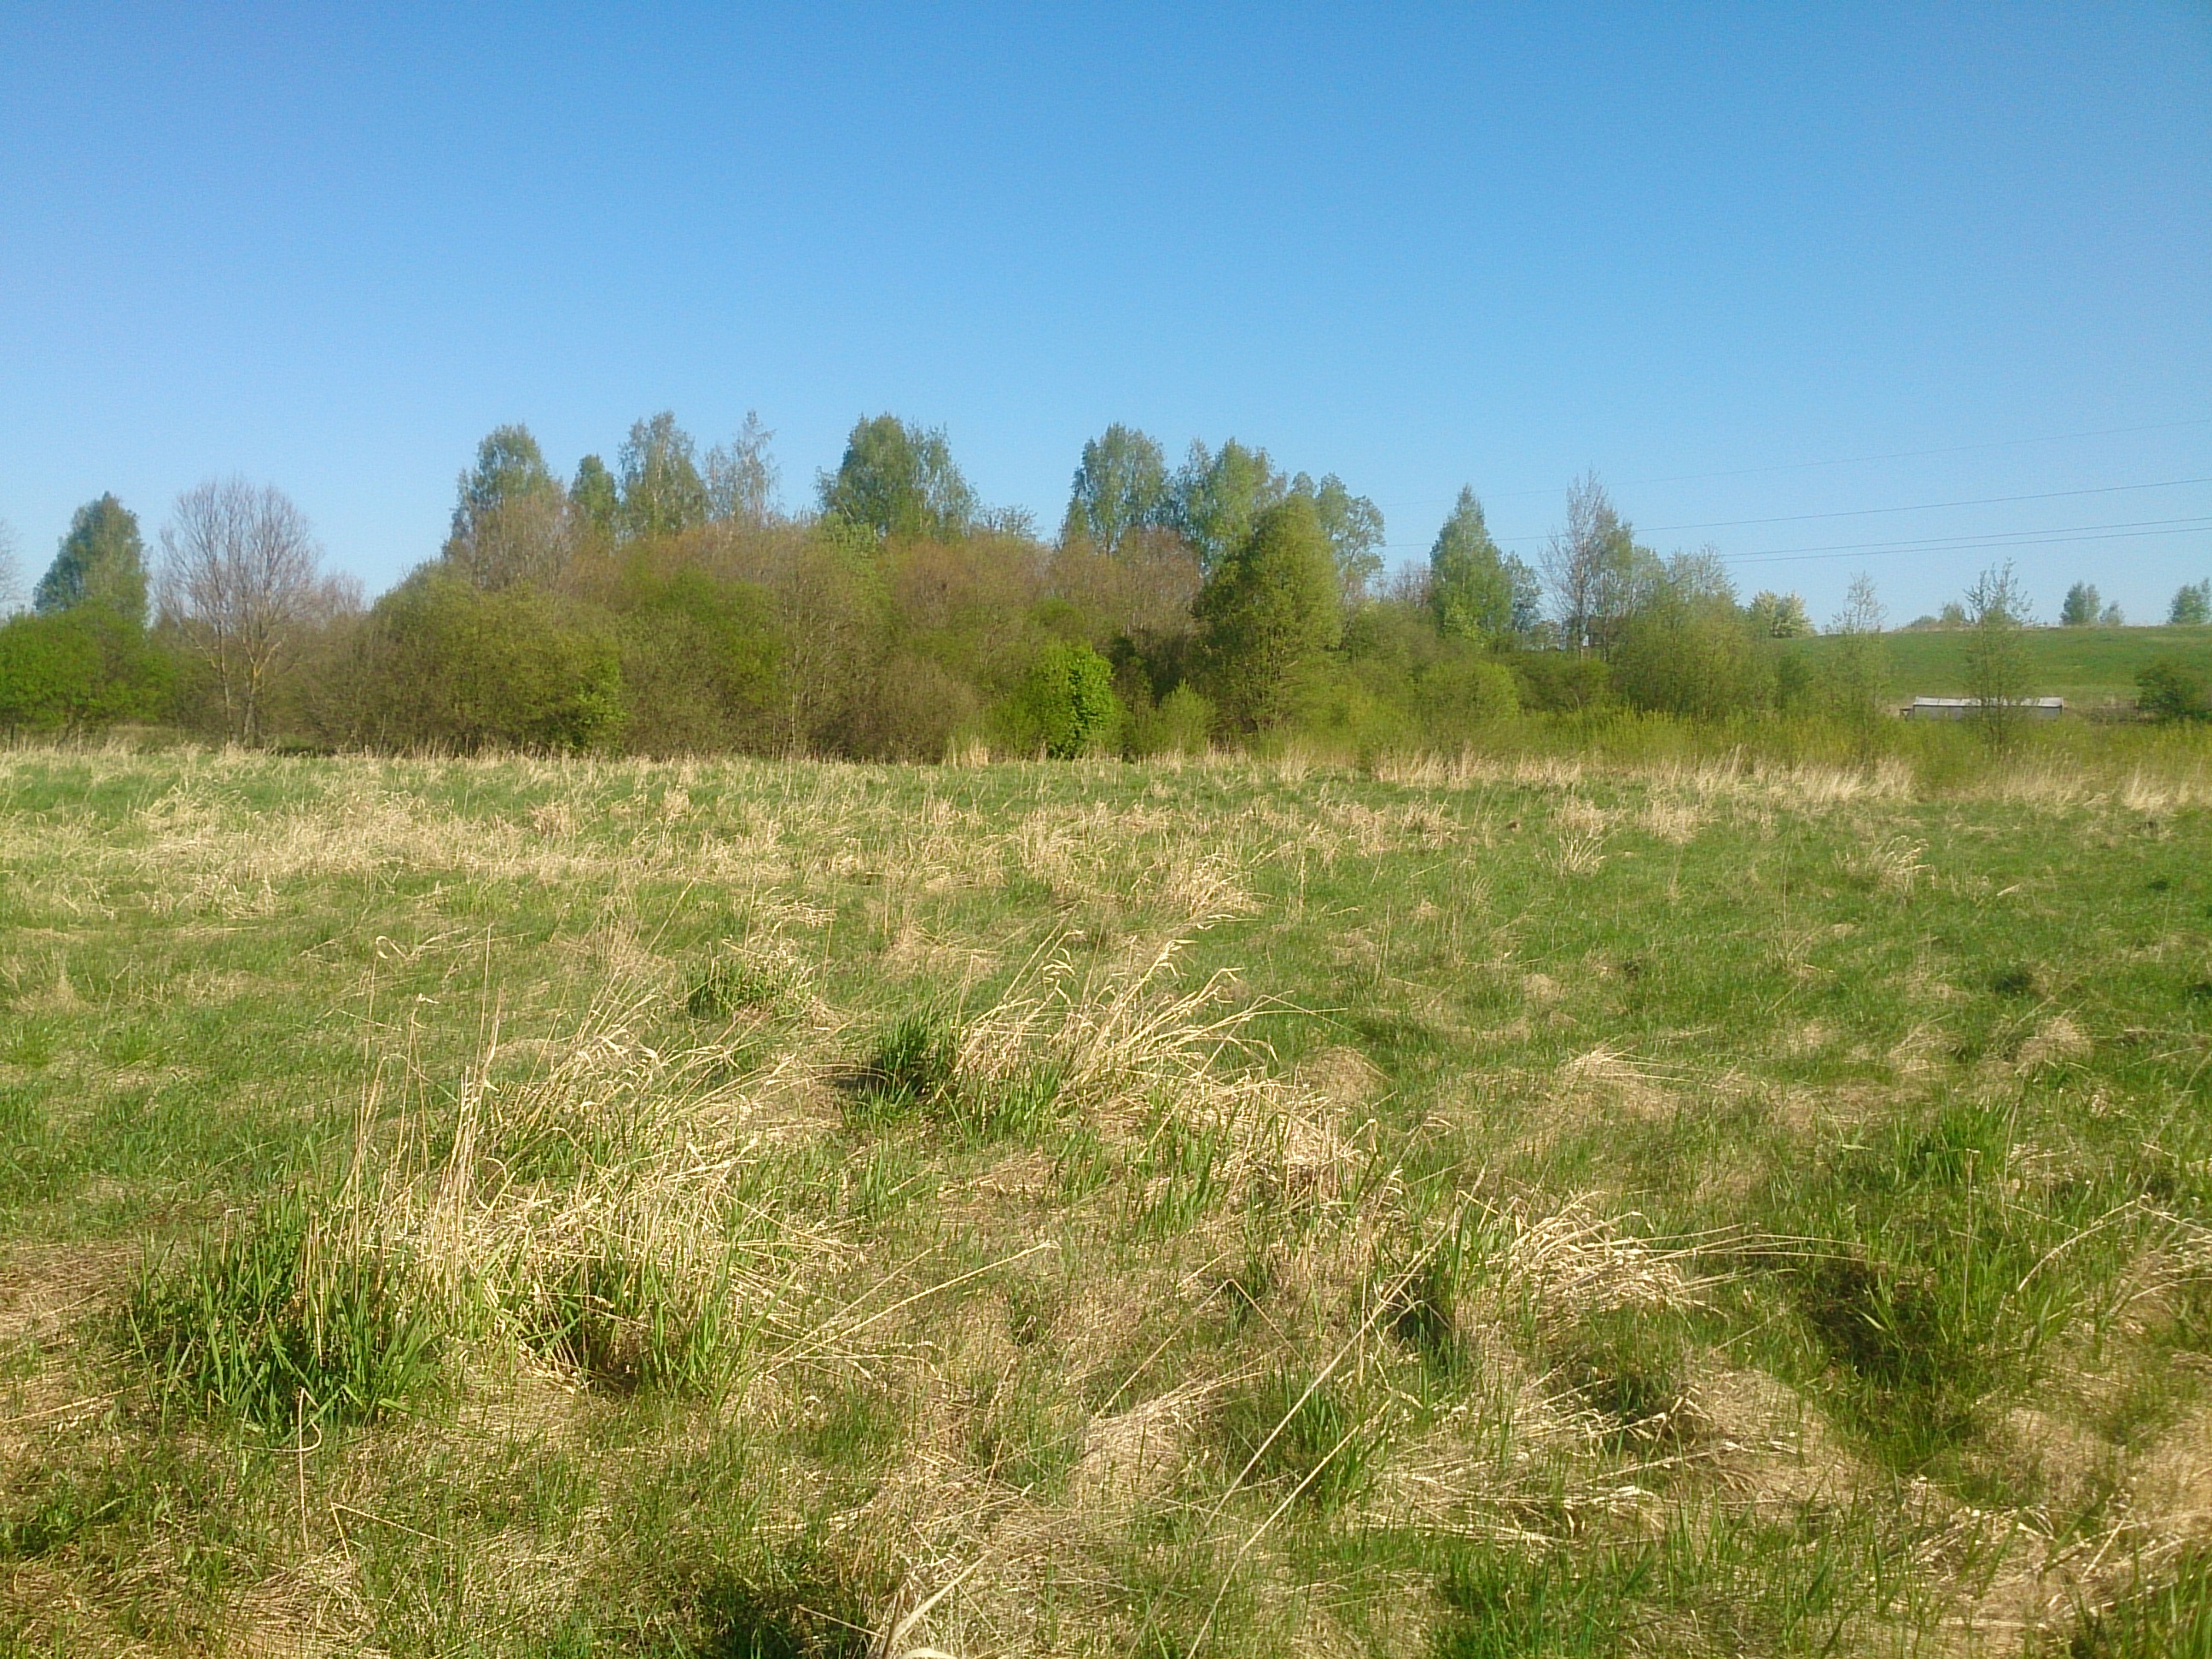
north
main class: Grassland
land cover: Spontaneously vegetated surfaces
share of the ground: > 75 %
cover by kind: herbaceous plants 100 %
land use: Agriculture (excluding fallow land and kitchen gardens)
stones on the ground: < 10 %
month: May
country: LV
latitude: 56.7743
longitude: 24.2771
